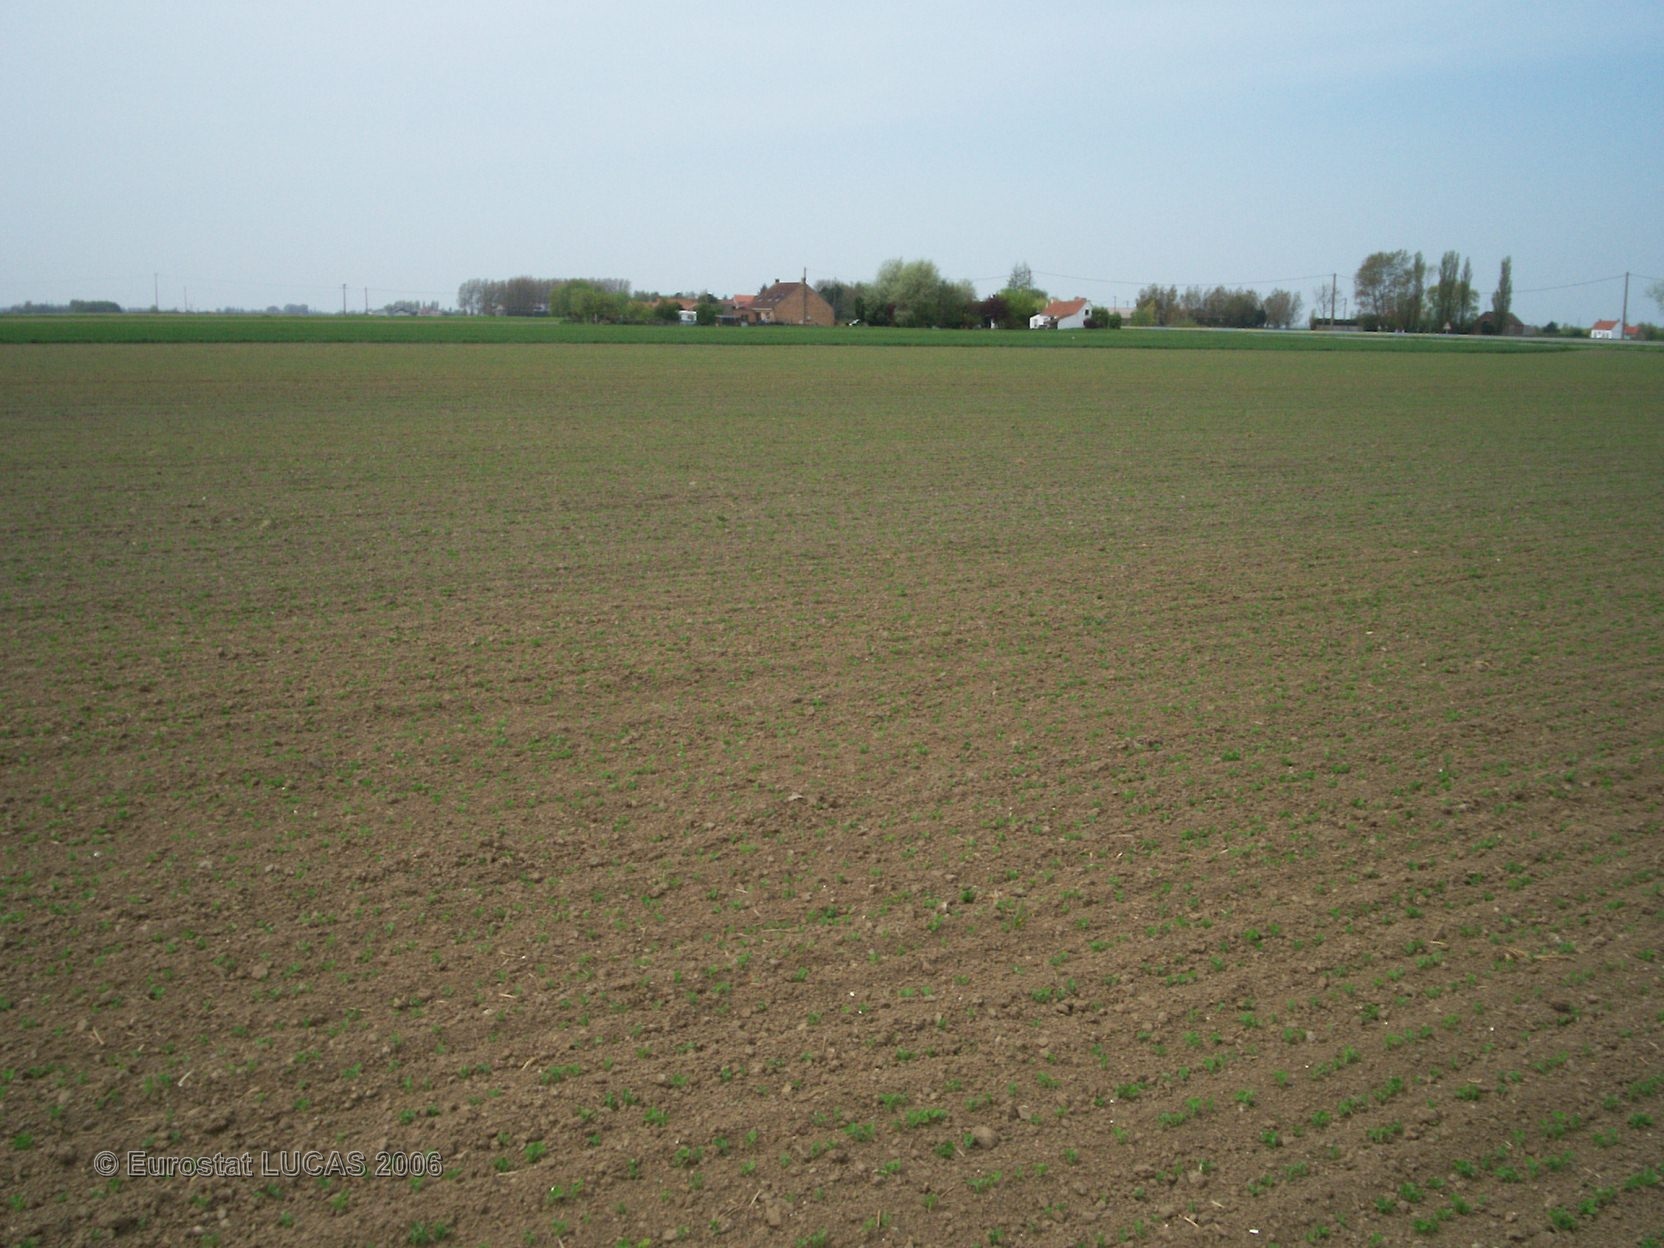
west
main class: Cropland
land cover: Dry pulses
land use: Agriculture (excluding fallow land and kitchen gardens)
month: May
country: FR
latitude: 50.9869
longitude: 2.5369
